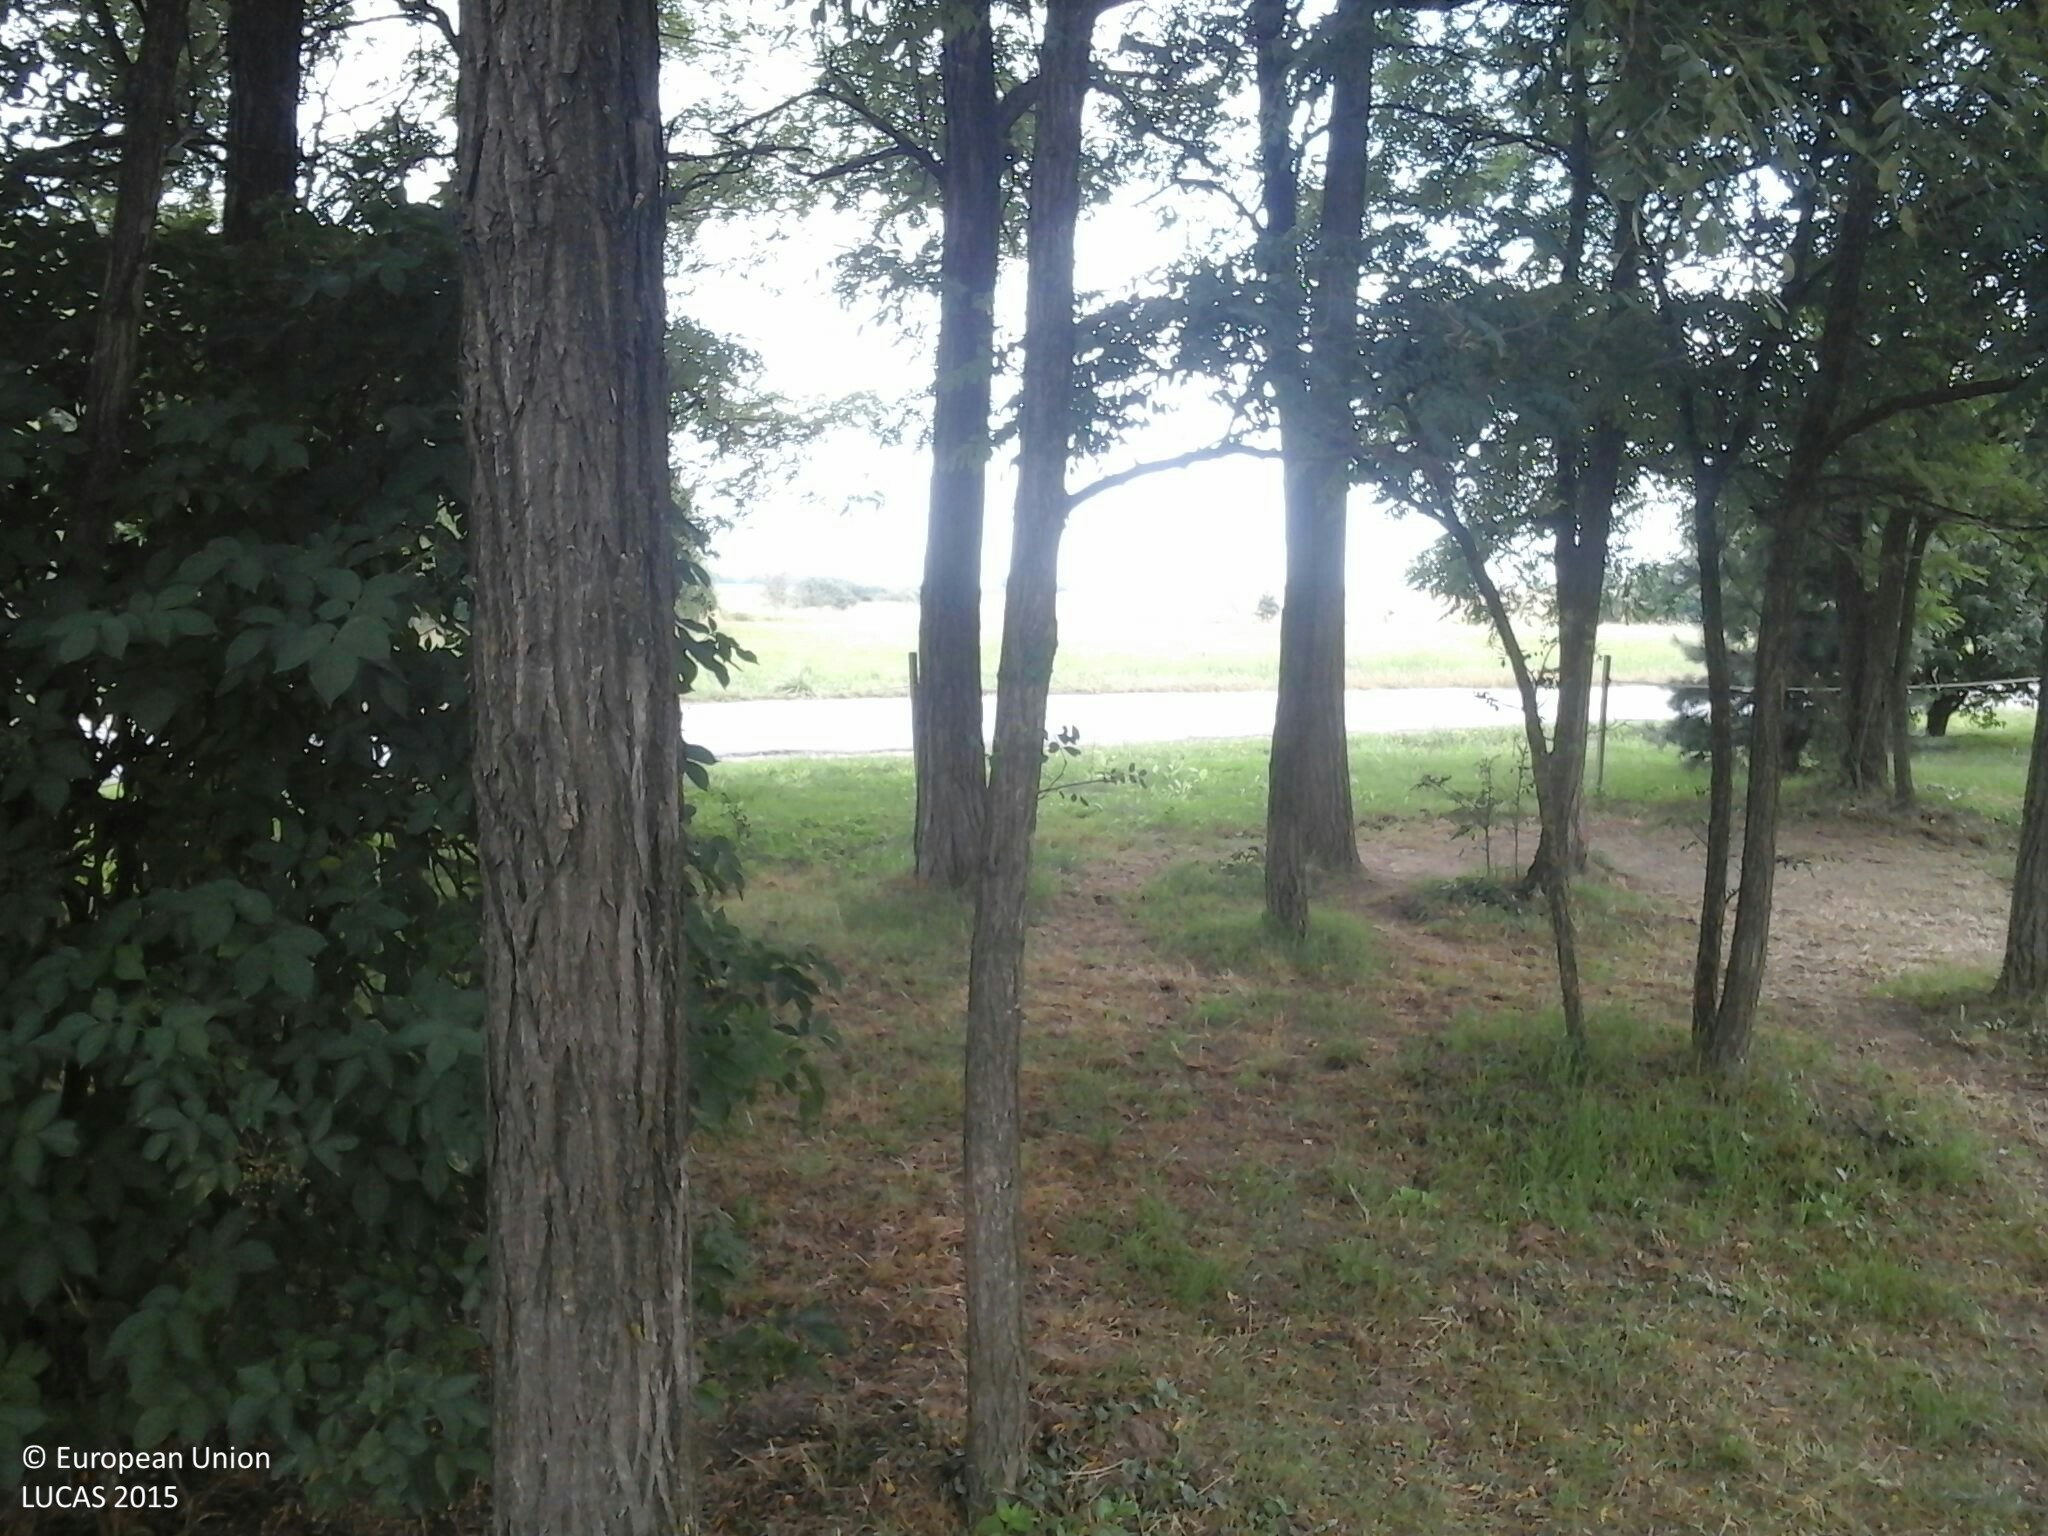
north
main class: Woodland
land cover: Broadleaved woodland
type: exotic forest
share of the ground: 50 - 75 %
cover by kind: herbaceous plants 60 %, broadleaved forest trees 40 %
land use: Residential
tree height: > 5 m
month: July
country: HU
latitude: 47.0702
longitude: 16.5740
